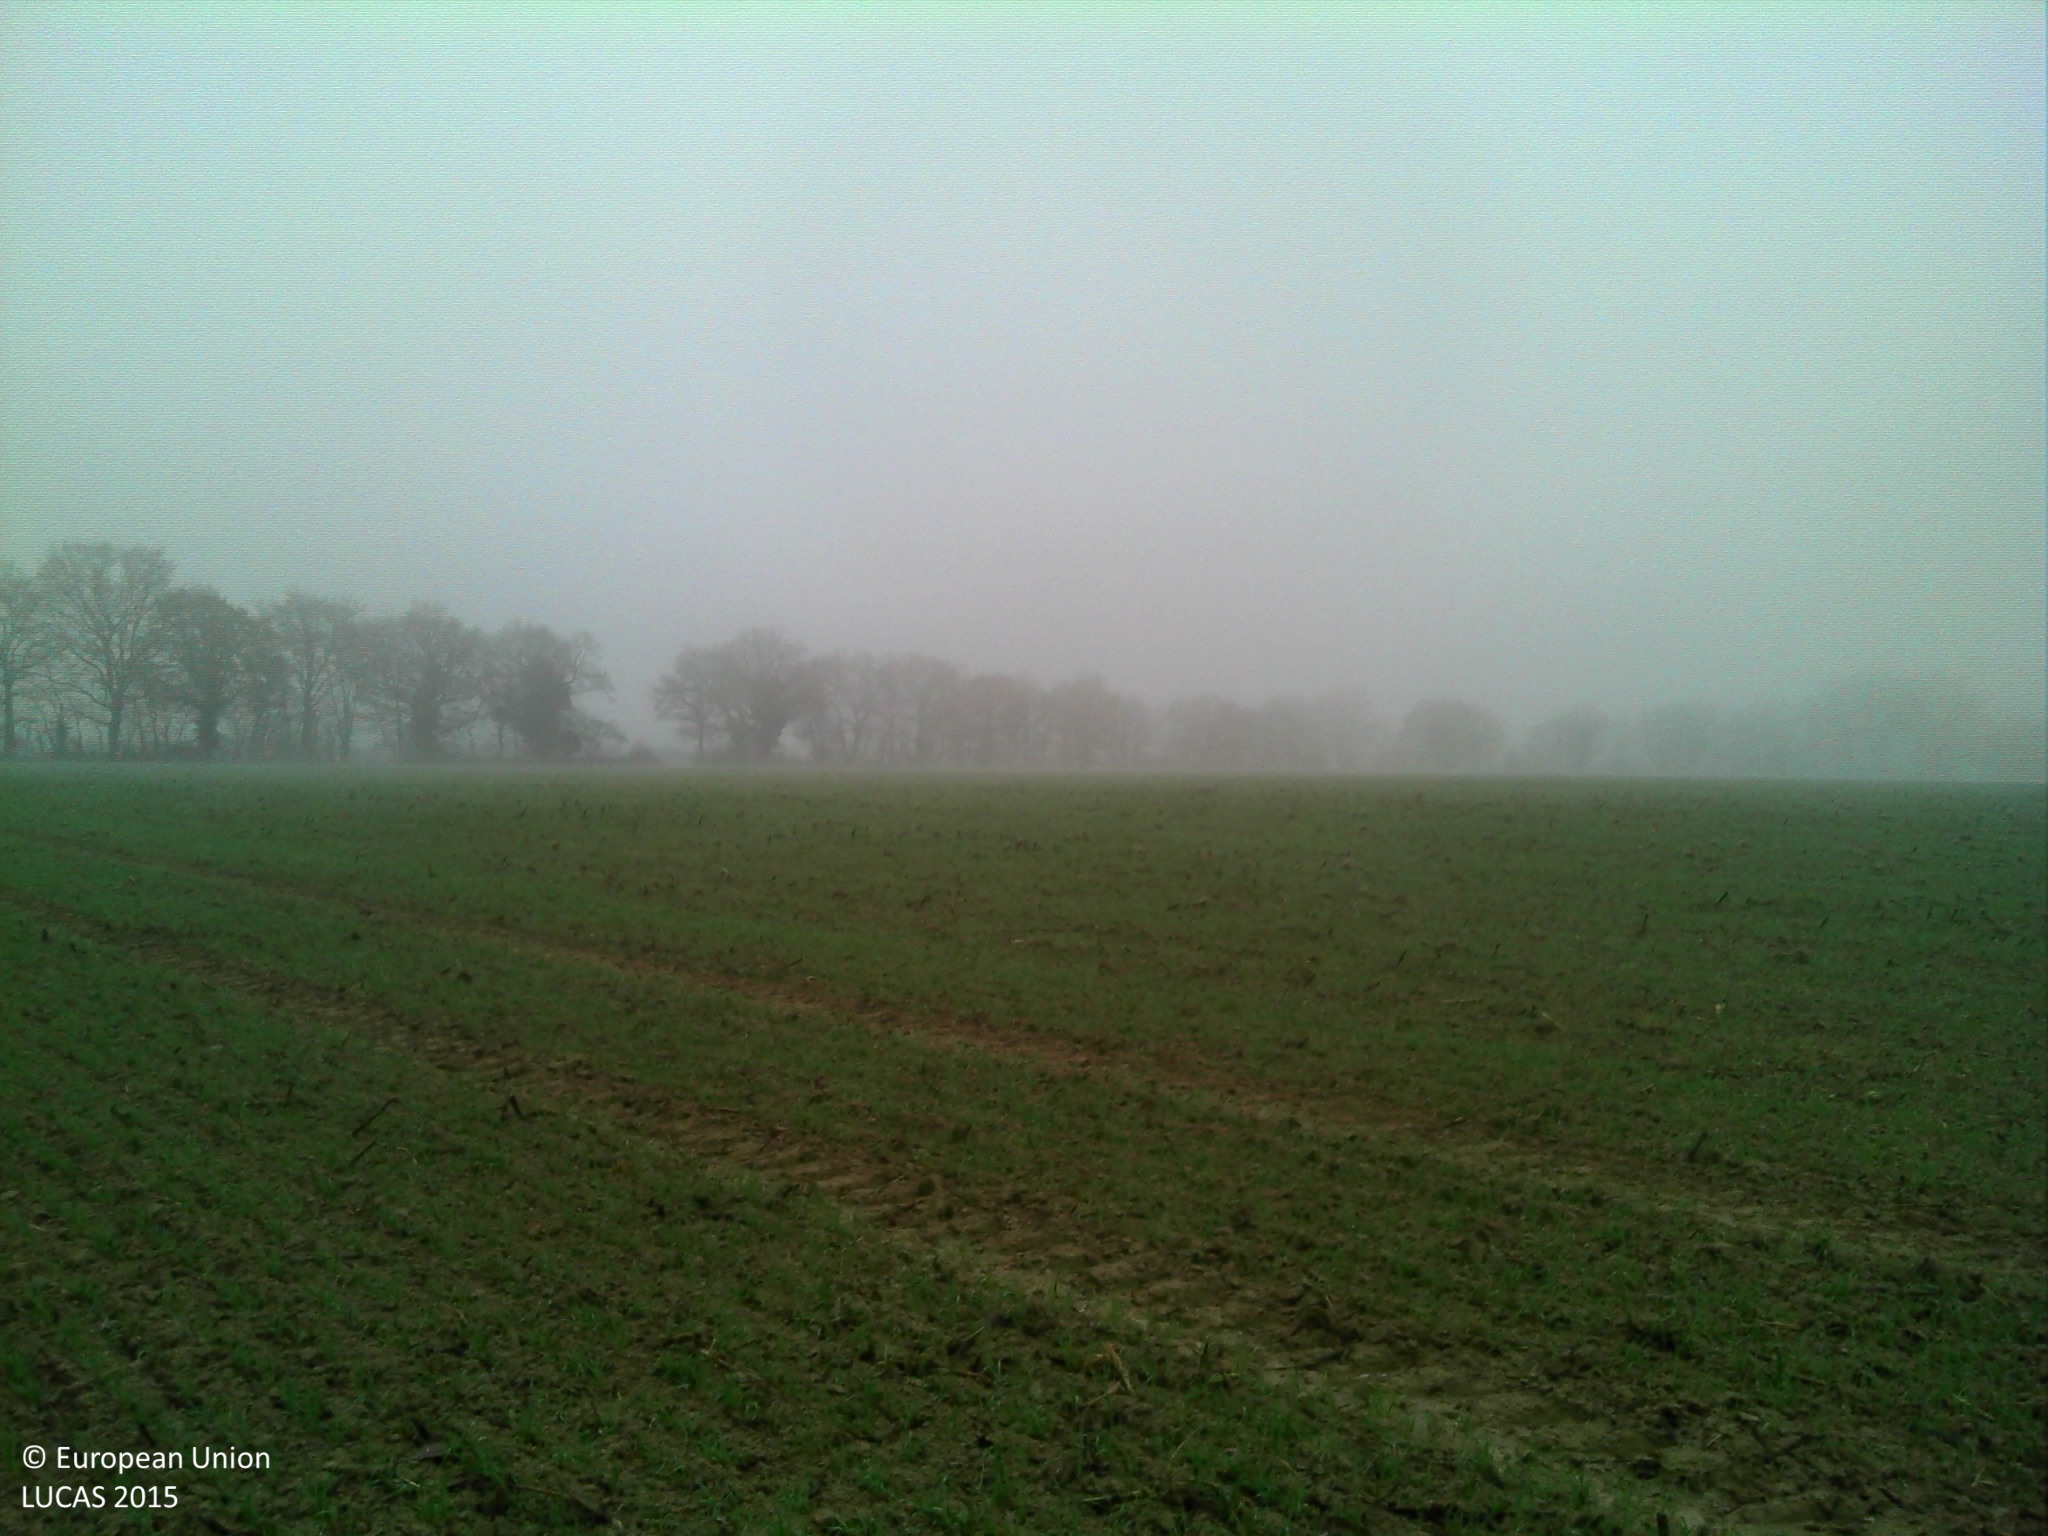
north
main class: Cropland
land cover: Common wheat
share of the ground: 50 - 75 %
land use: Agriculture (excluding fallow land and kitchen gardens)
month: November
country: FR
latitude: 46.5418
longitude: 3.6486
